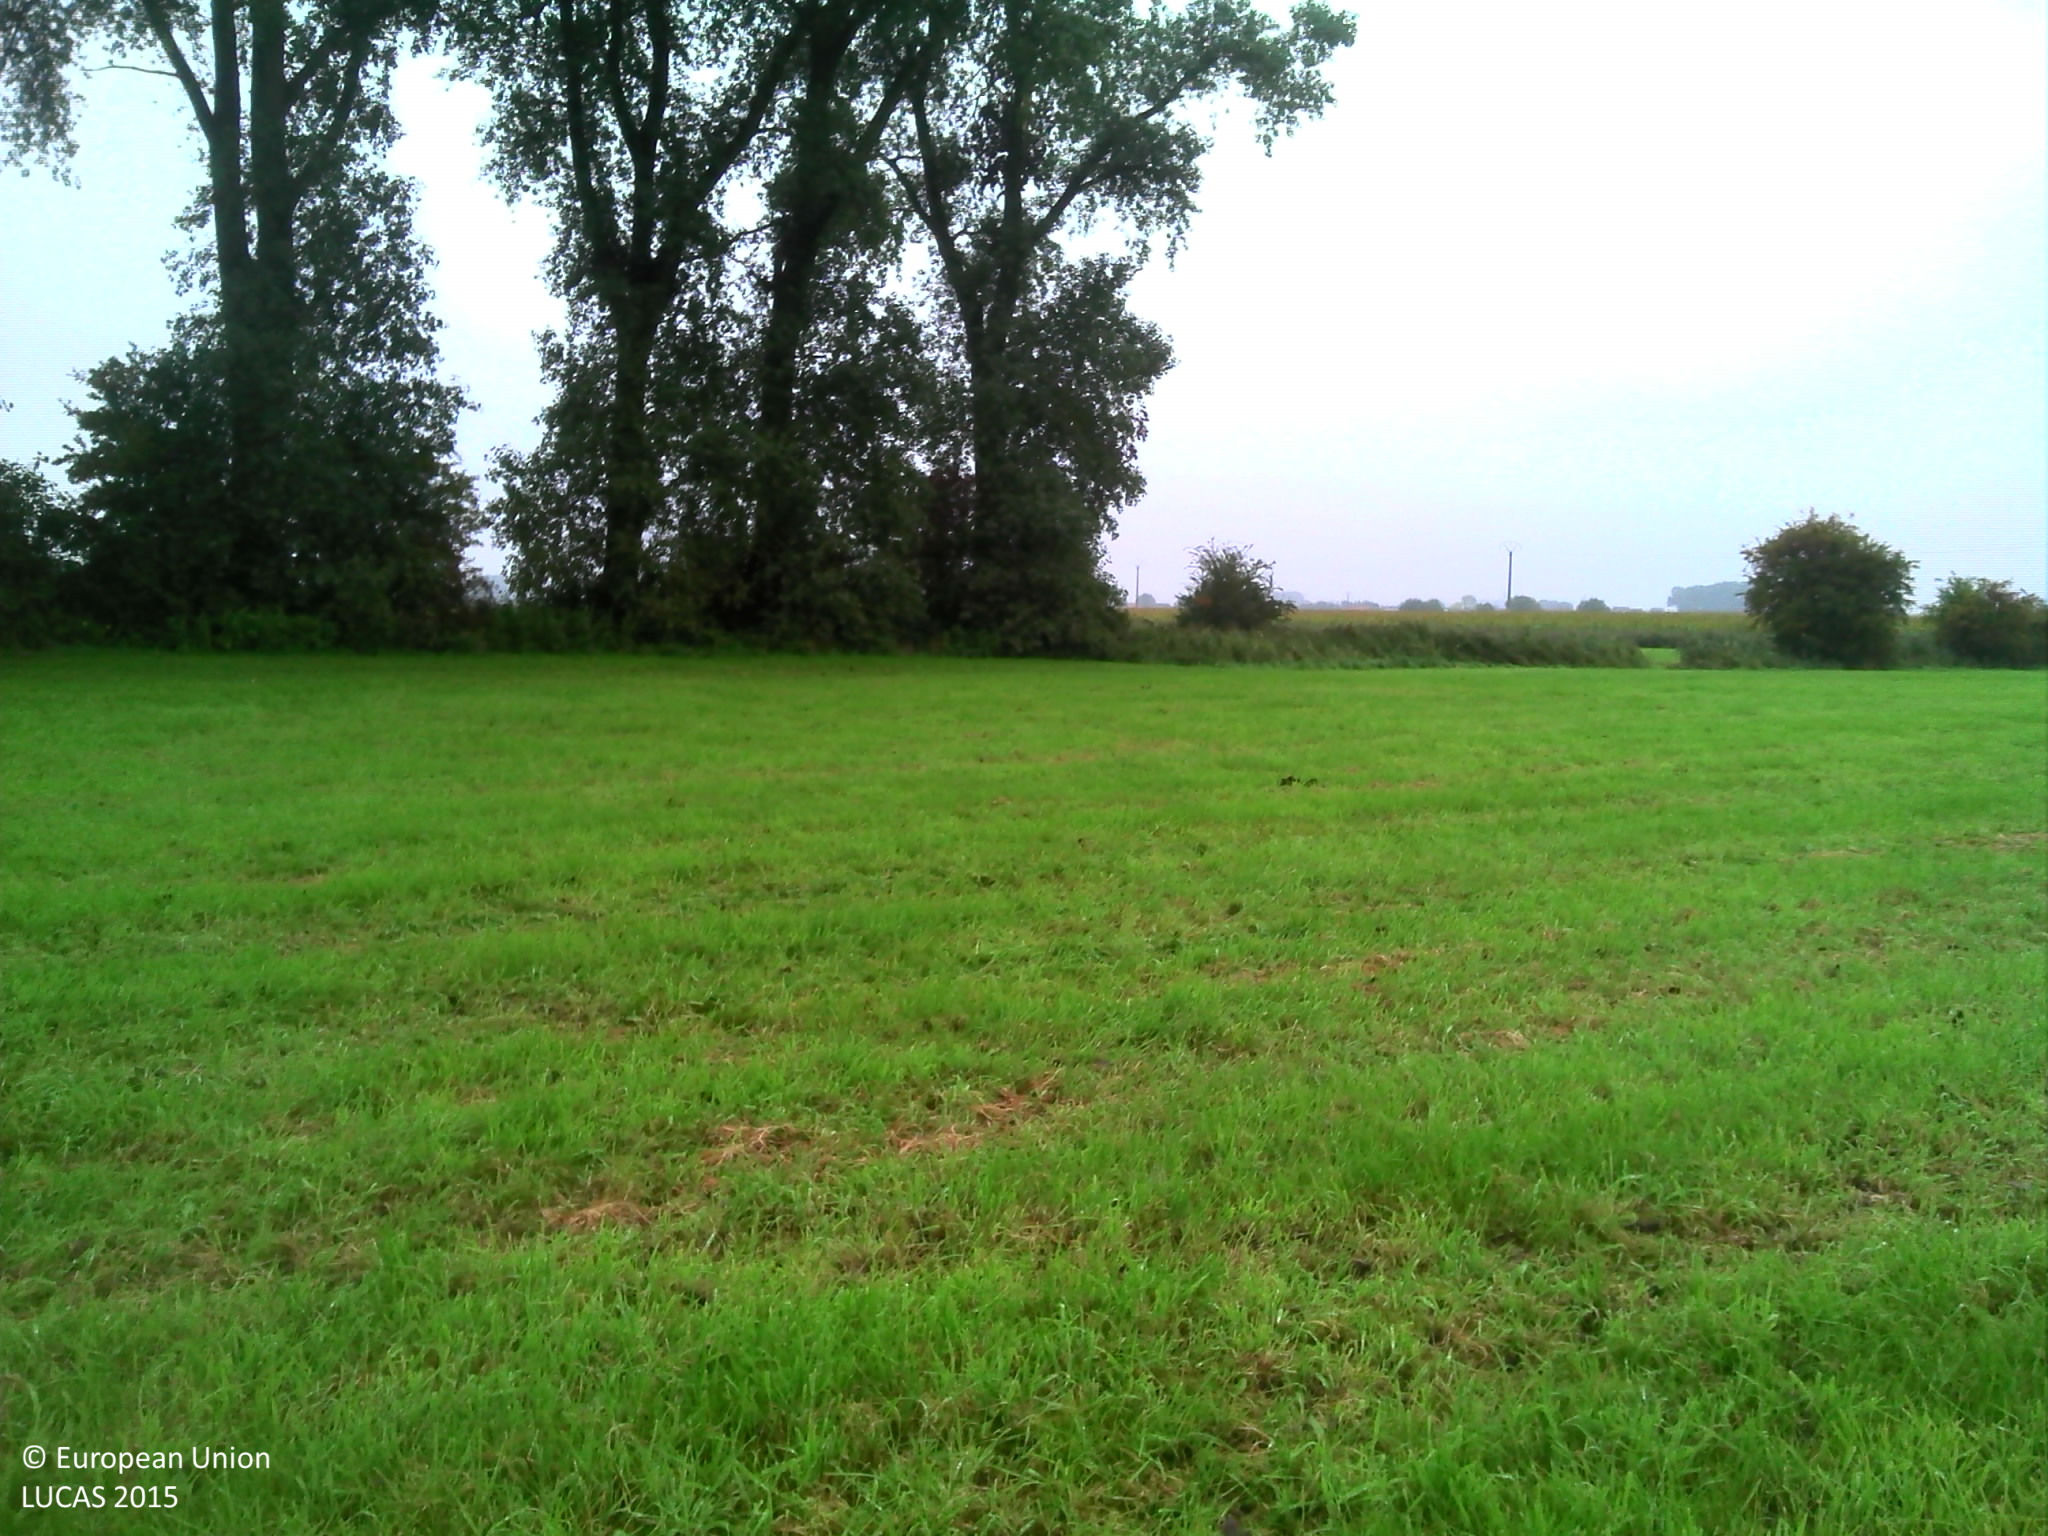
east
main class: Grassland
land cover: Grassland without tree/shrub cover
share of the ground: > 75 %
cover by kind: herbaceous plants 100 %
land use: Agriculture (excluding fallow land and kitchen gardens)
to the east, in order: Grassland without tree/shrub cover; Lines of trees; Grass margins; Grassland without tree/shrub cover; Fences; Ditches and canals; Grassland without tree/shrub cover; Grass margins; Inland fresh running water; Grass margins; Maize
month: October
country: BE
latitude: 51.0066
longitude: 2.8490
